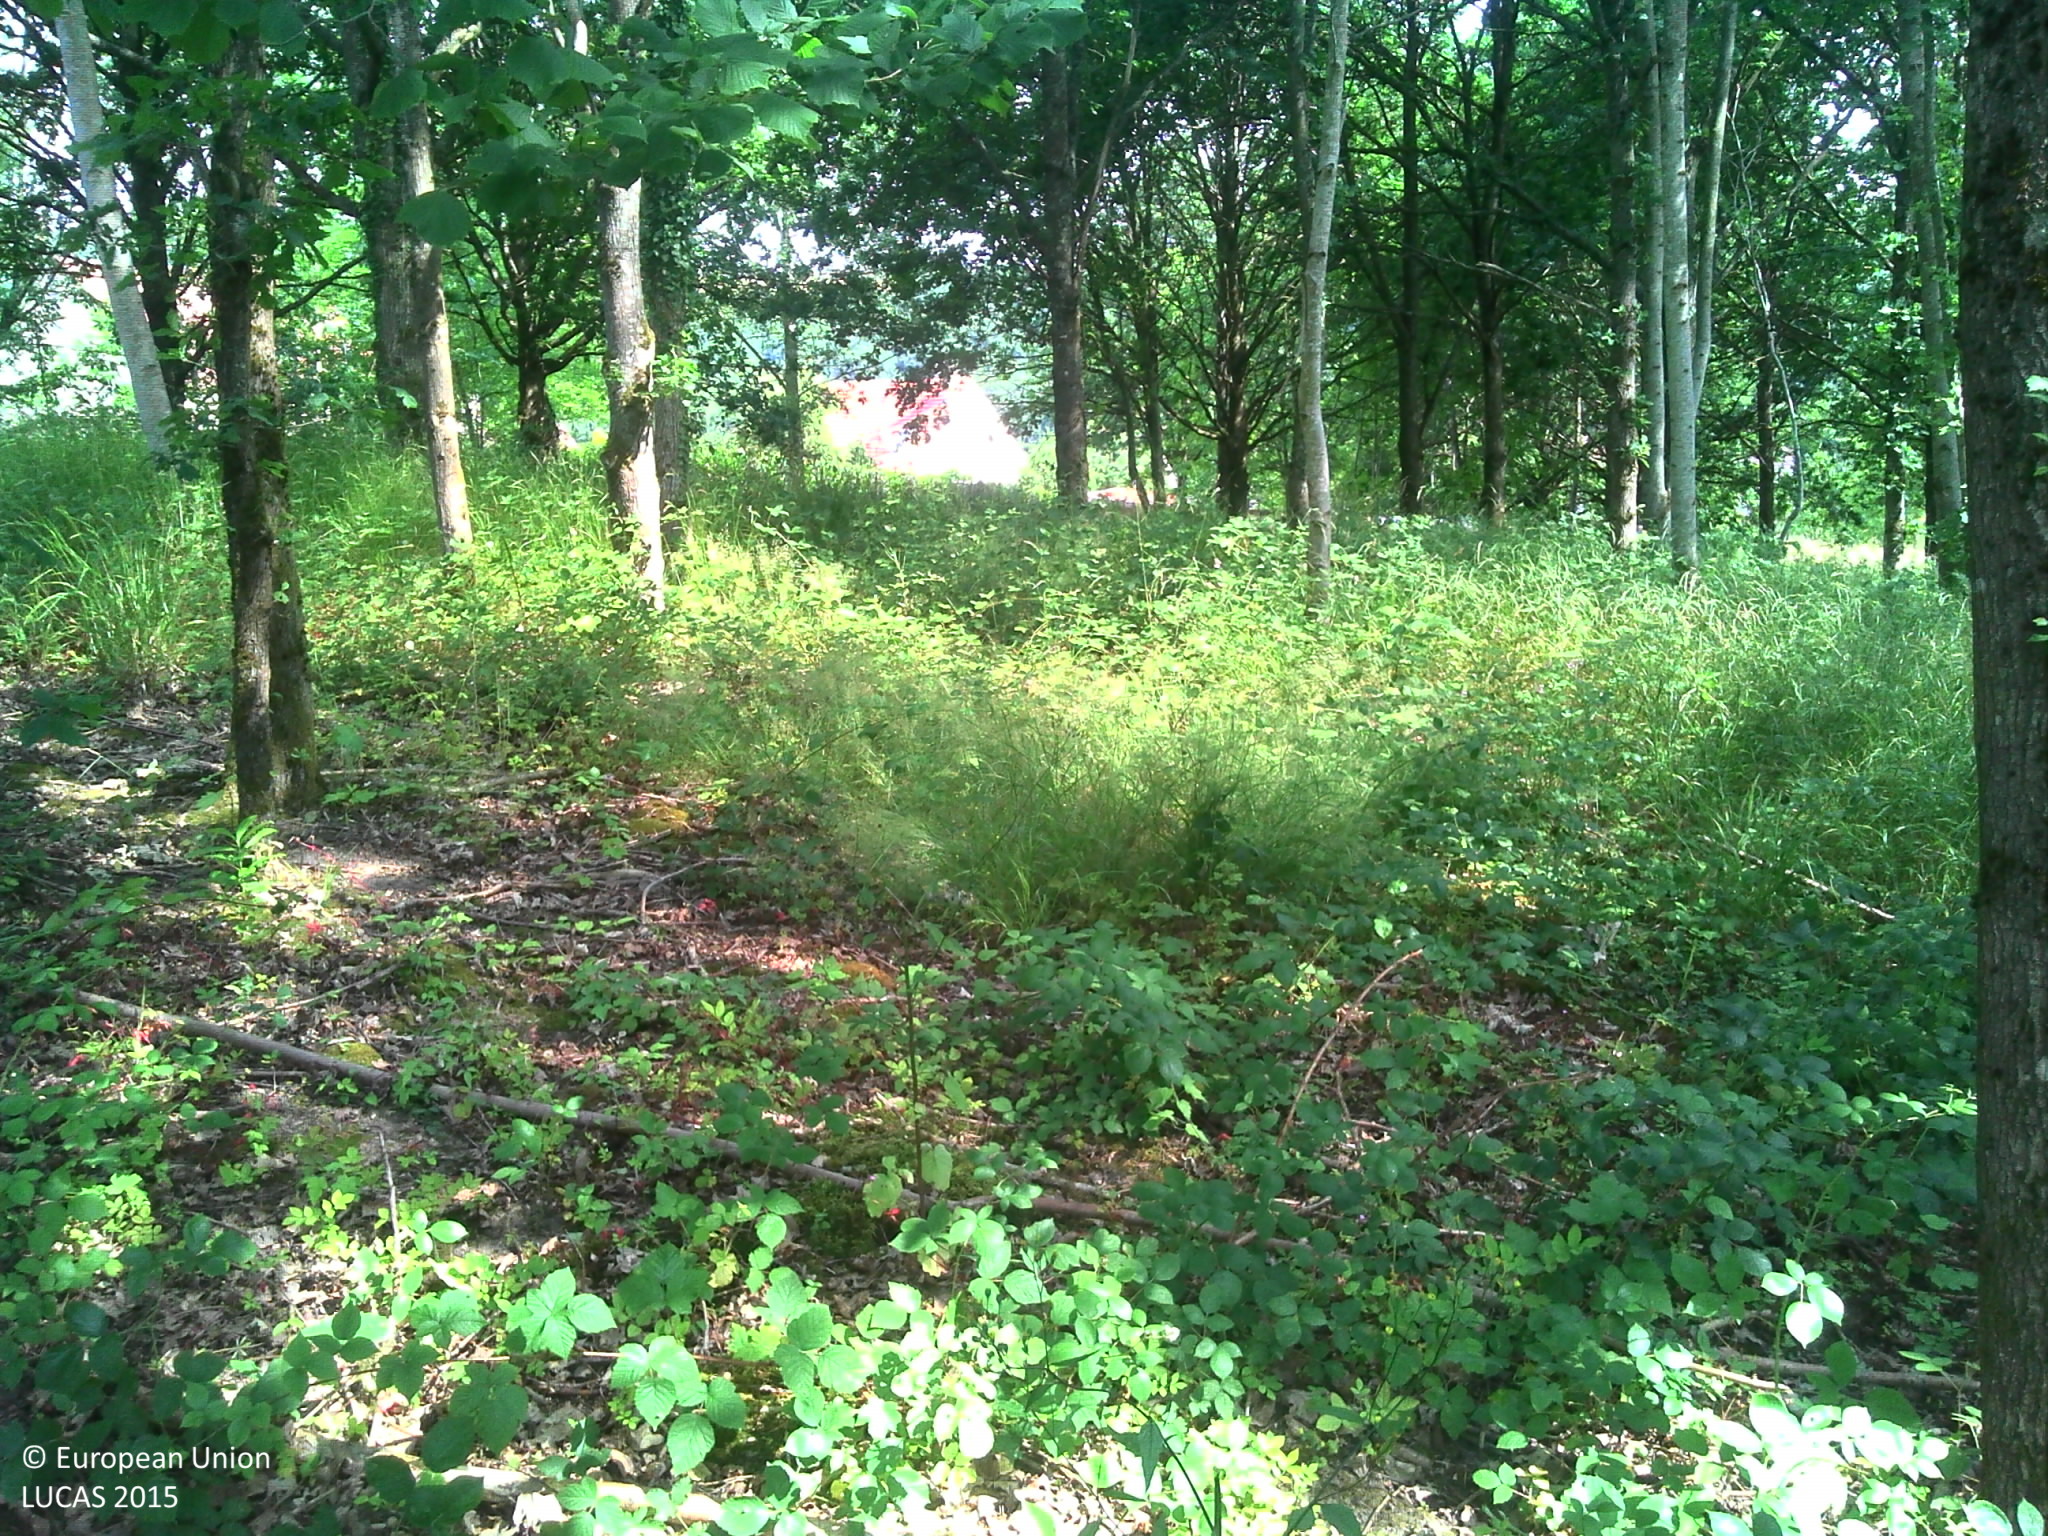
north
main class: Woodland
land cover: Broadleaved woodland
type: mesophytic deciduous forest
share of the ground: > 75 %
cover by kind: broadleaved forest trees 80 %, shrubs 10 %, herbaceous plants 10 %
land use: Forestry
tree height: > 5 m
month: July
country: FR
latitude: 49.1057
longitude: 3.3490
